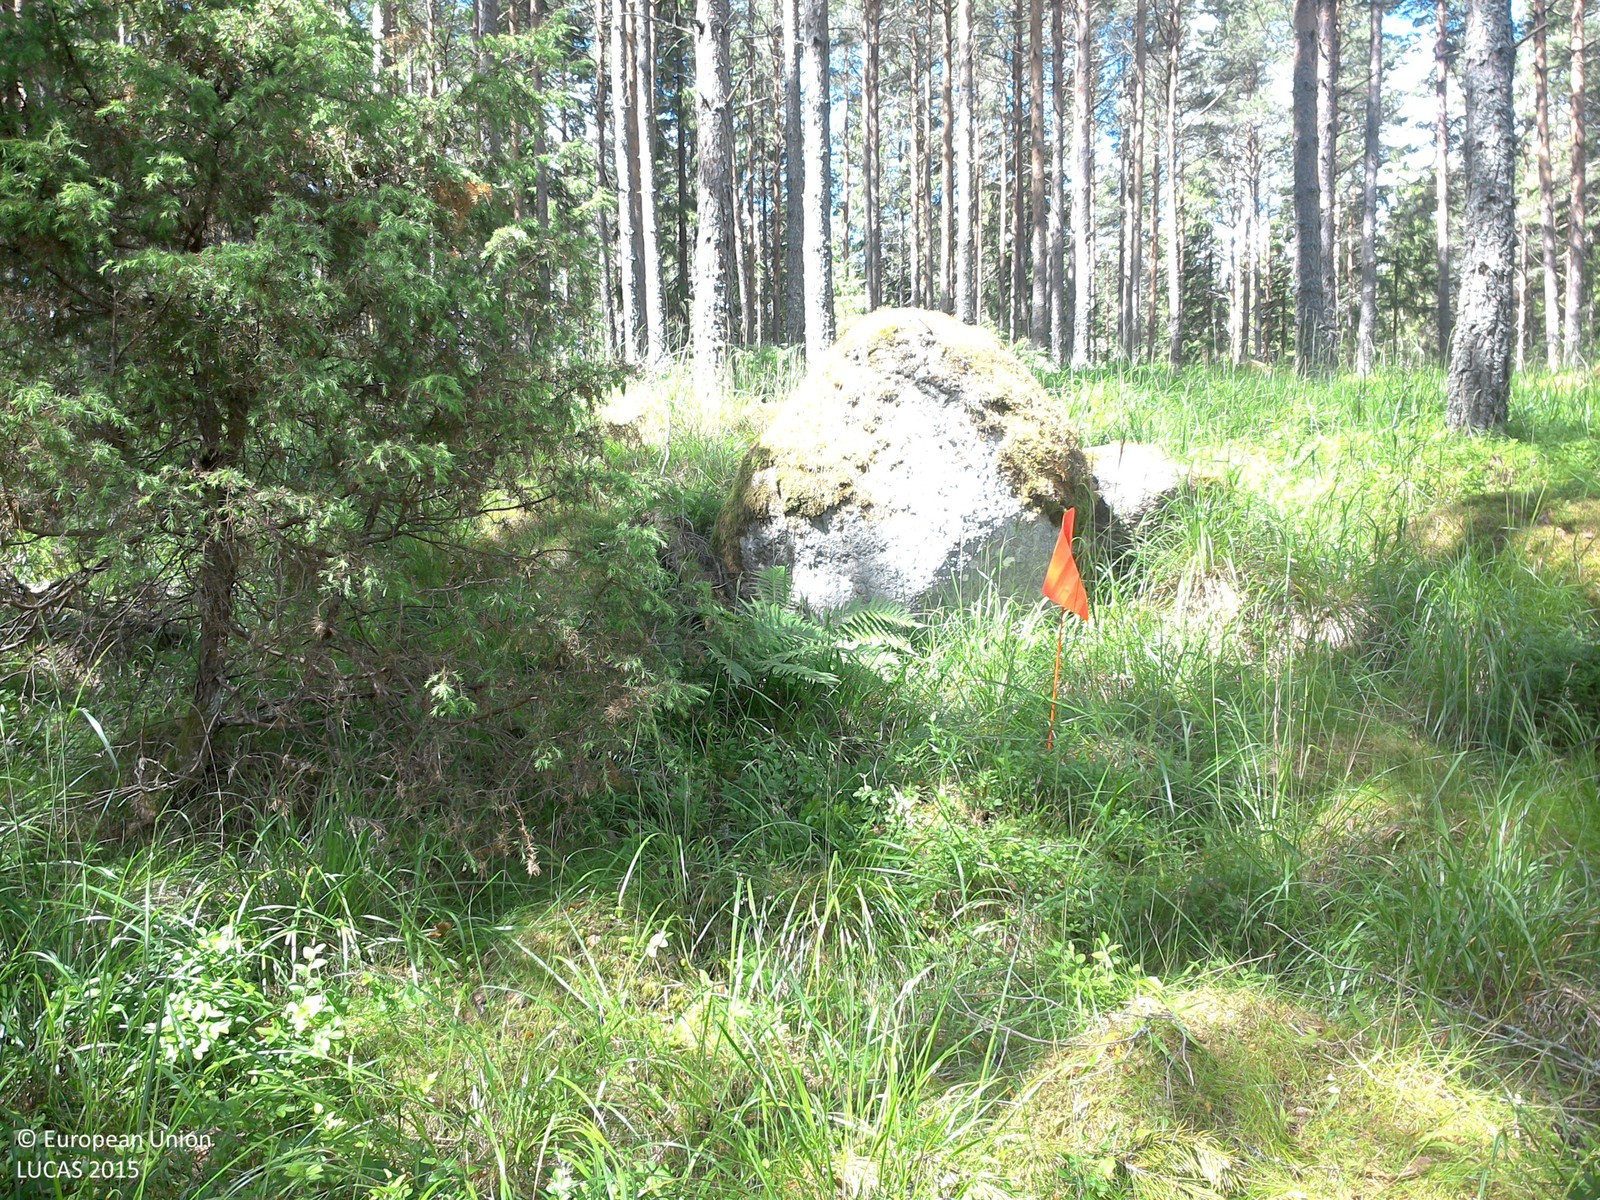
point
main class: Woodland
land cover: Pine dominated coniferous woodland
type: boreal forest
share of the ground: 50 - 75 %
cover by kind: coniferous forest trees 70 %, herbaceous plants 30 %
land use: Forestry
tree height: > 5 m
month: June
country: SE
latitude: 57.9804
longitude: 15.9318
